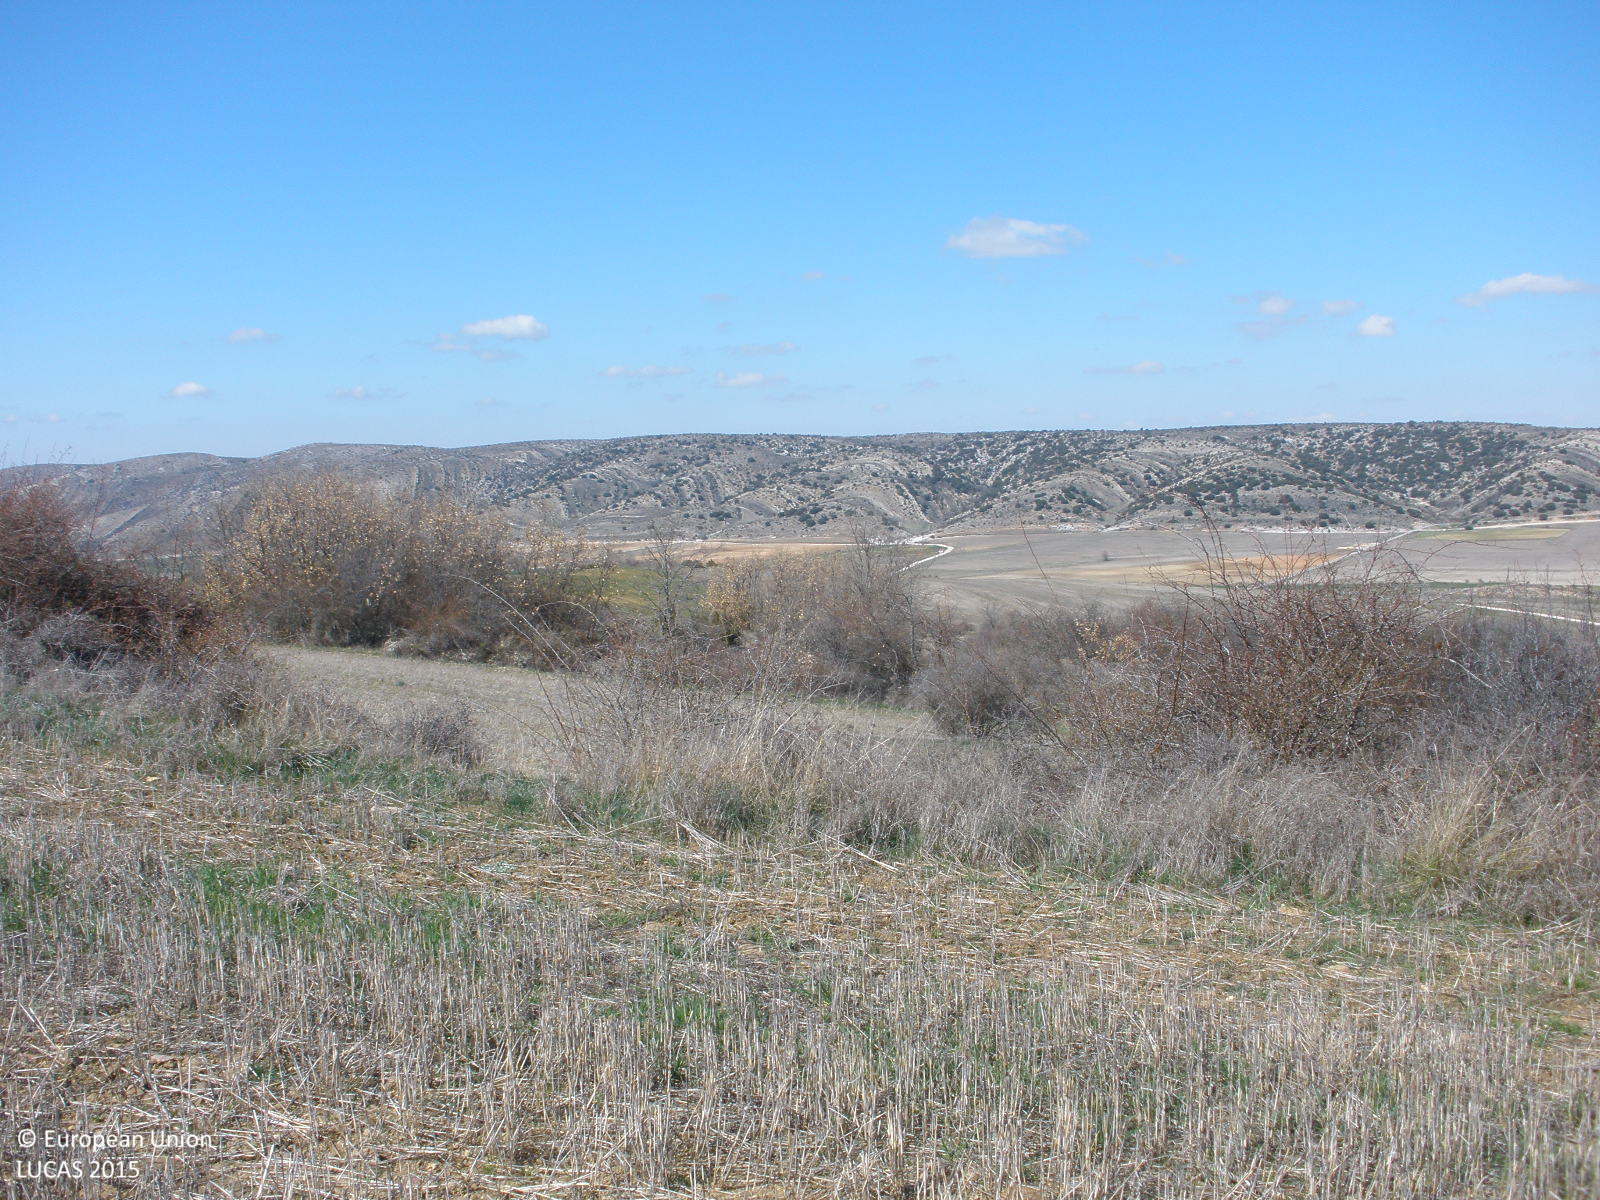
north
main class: Grassland
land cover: Spontaneously vegetated surfaces
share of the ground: 50 - 75 %
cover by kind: herbaceous plants 70 %, unconsolidated bare surface 30 %
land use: Agriculture (excluding fallow land and kitchen gardens)
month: April
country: ES
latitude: 40.9871
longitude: -1.0830
